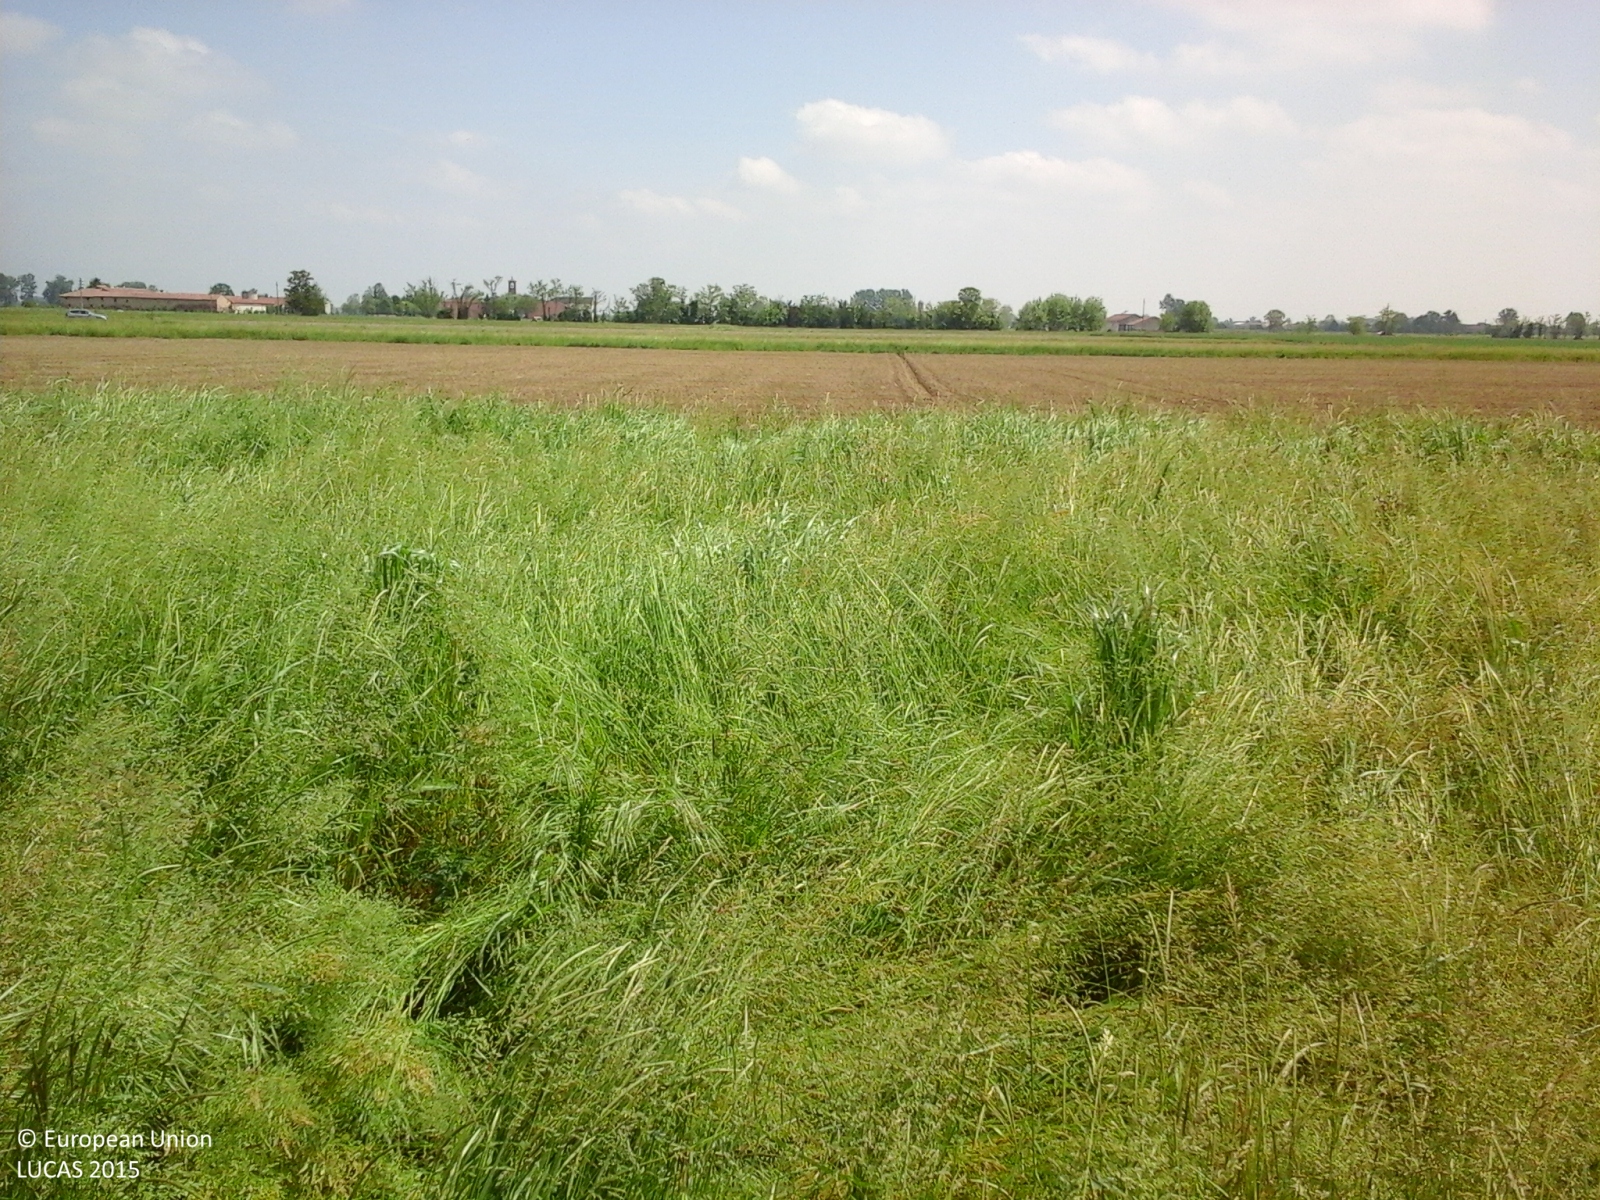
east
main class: Grassland
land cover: Spontaneously vegetated surfaces
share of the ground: > 75 %
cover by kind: herbaceous plants 100 %
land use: Agriculture (excluding fallow land and kitchen gardens)
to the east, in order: Spontaneously vegetated surfaces; Ditches and canals; Grass margins; Soya; Ditches and canals; Grass margins; Tracks; Soya; Ditches and canals; Grass margins; Other bare soil
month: May
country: IT
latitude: 45.1075
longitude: 10.2664
